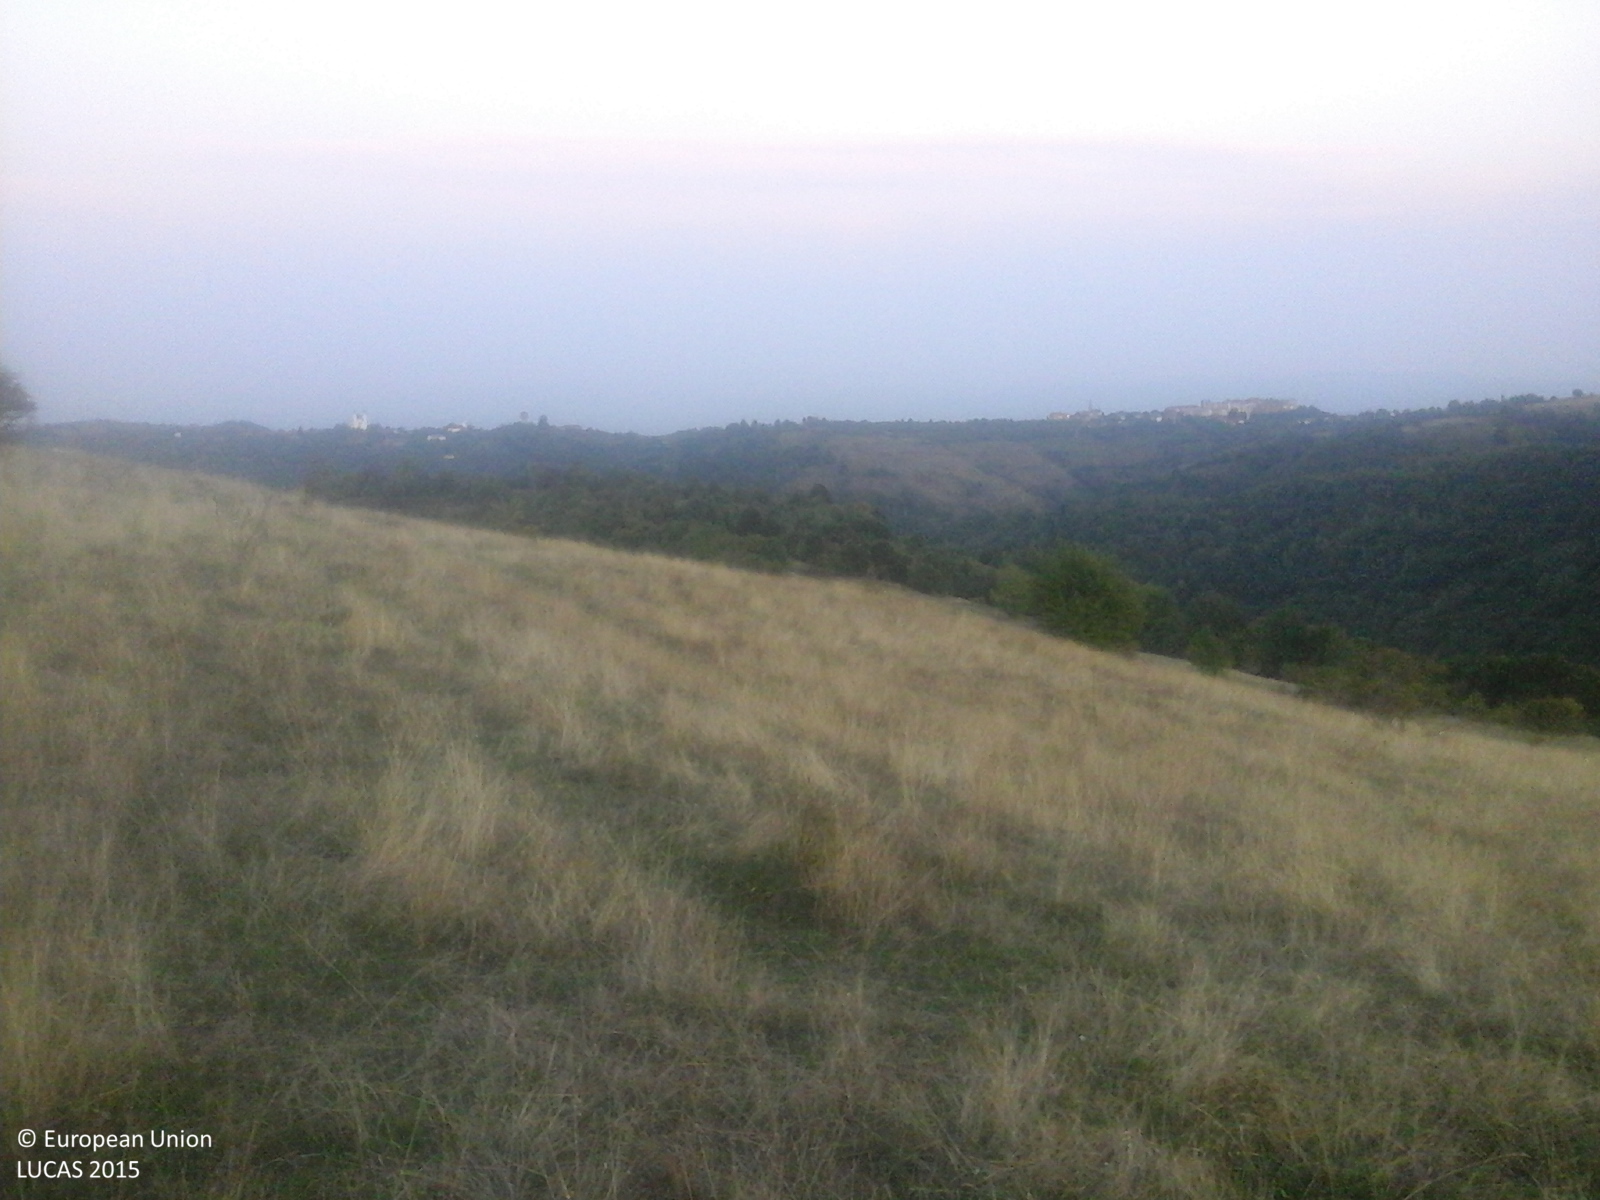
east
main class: Grassland
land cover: Grassland without tree/shrub cover
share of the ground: > 75 %
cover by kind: herbaceous plants 100 %
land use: Agriculture (excluding fallow land and kitchen gardens)
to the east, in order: Grassland without tree/shrub cover; Grassland with sparse tree/shrub cover; Grassland without tree/shrub cover; Tracks; Grassland with sparse tree/shrub cover
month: September
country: RO
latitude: 45.7116
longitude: 22.7550
